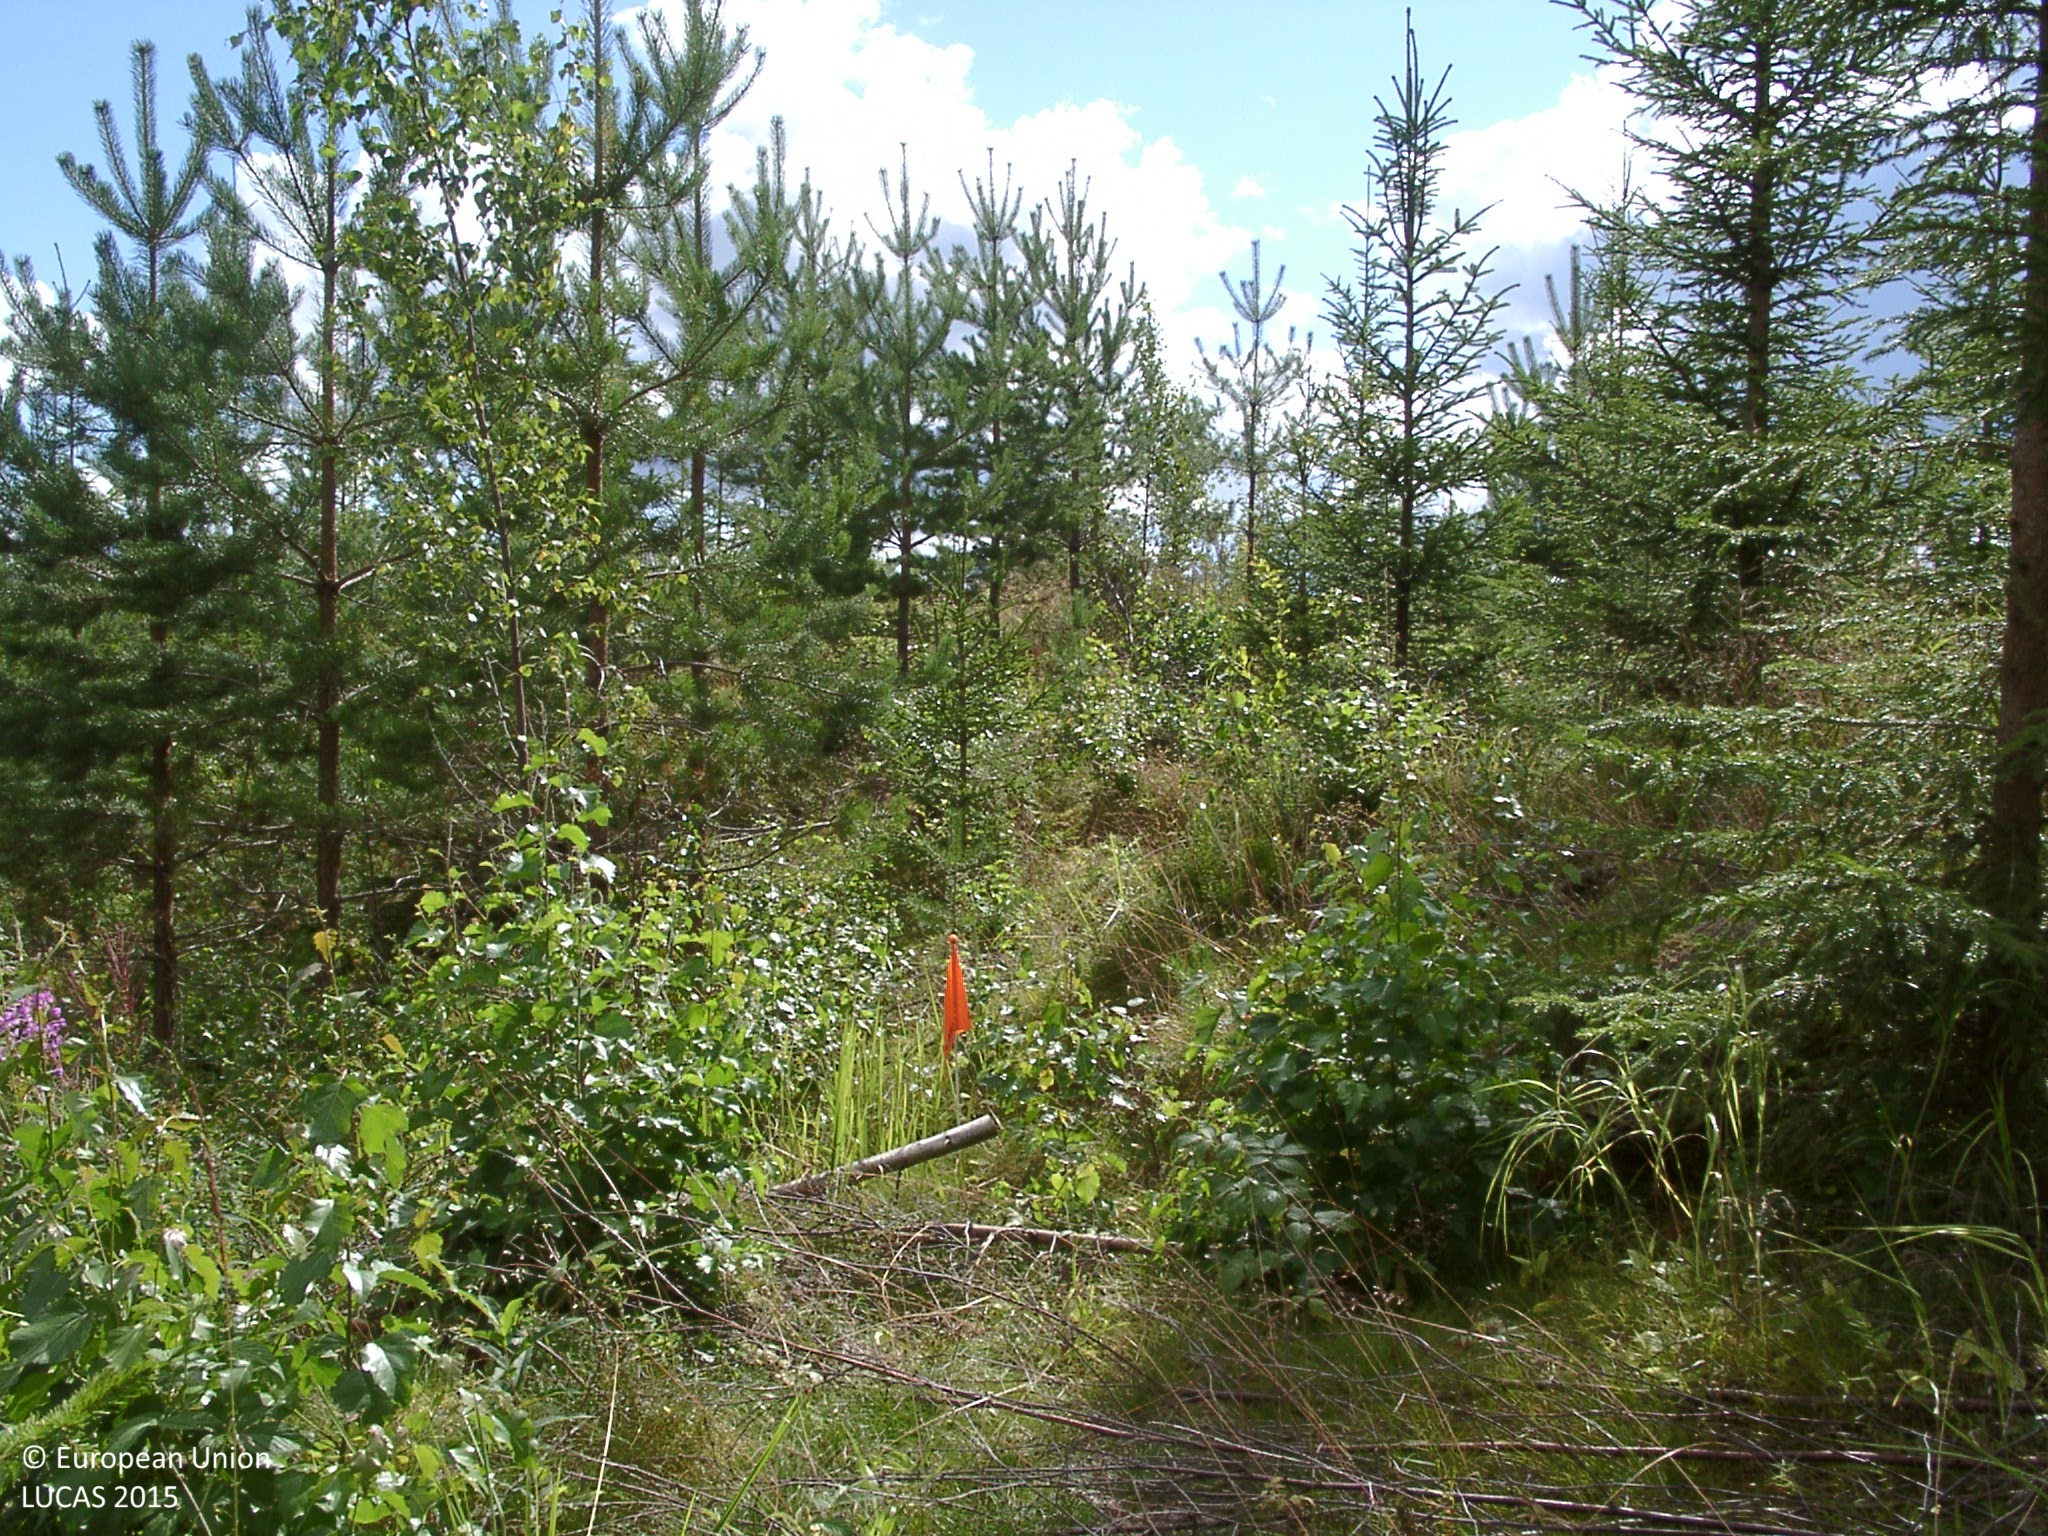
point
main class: Woodland
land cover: Other coniferous woodland
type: boreal forest
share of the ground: 50 - 75 %
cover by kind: coniferous forest trees 50 %, broadleaved forest trees 15 %, shrubs 10 %, herbaceous plants 10 %, lichens and mosses 5 %
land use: Forestry
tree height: < 5 m
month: August
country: FI
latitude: 62.3467
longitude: 25.5855
